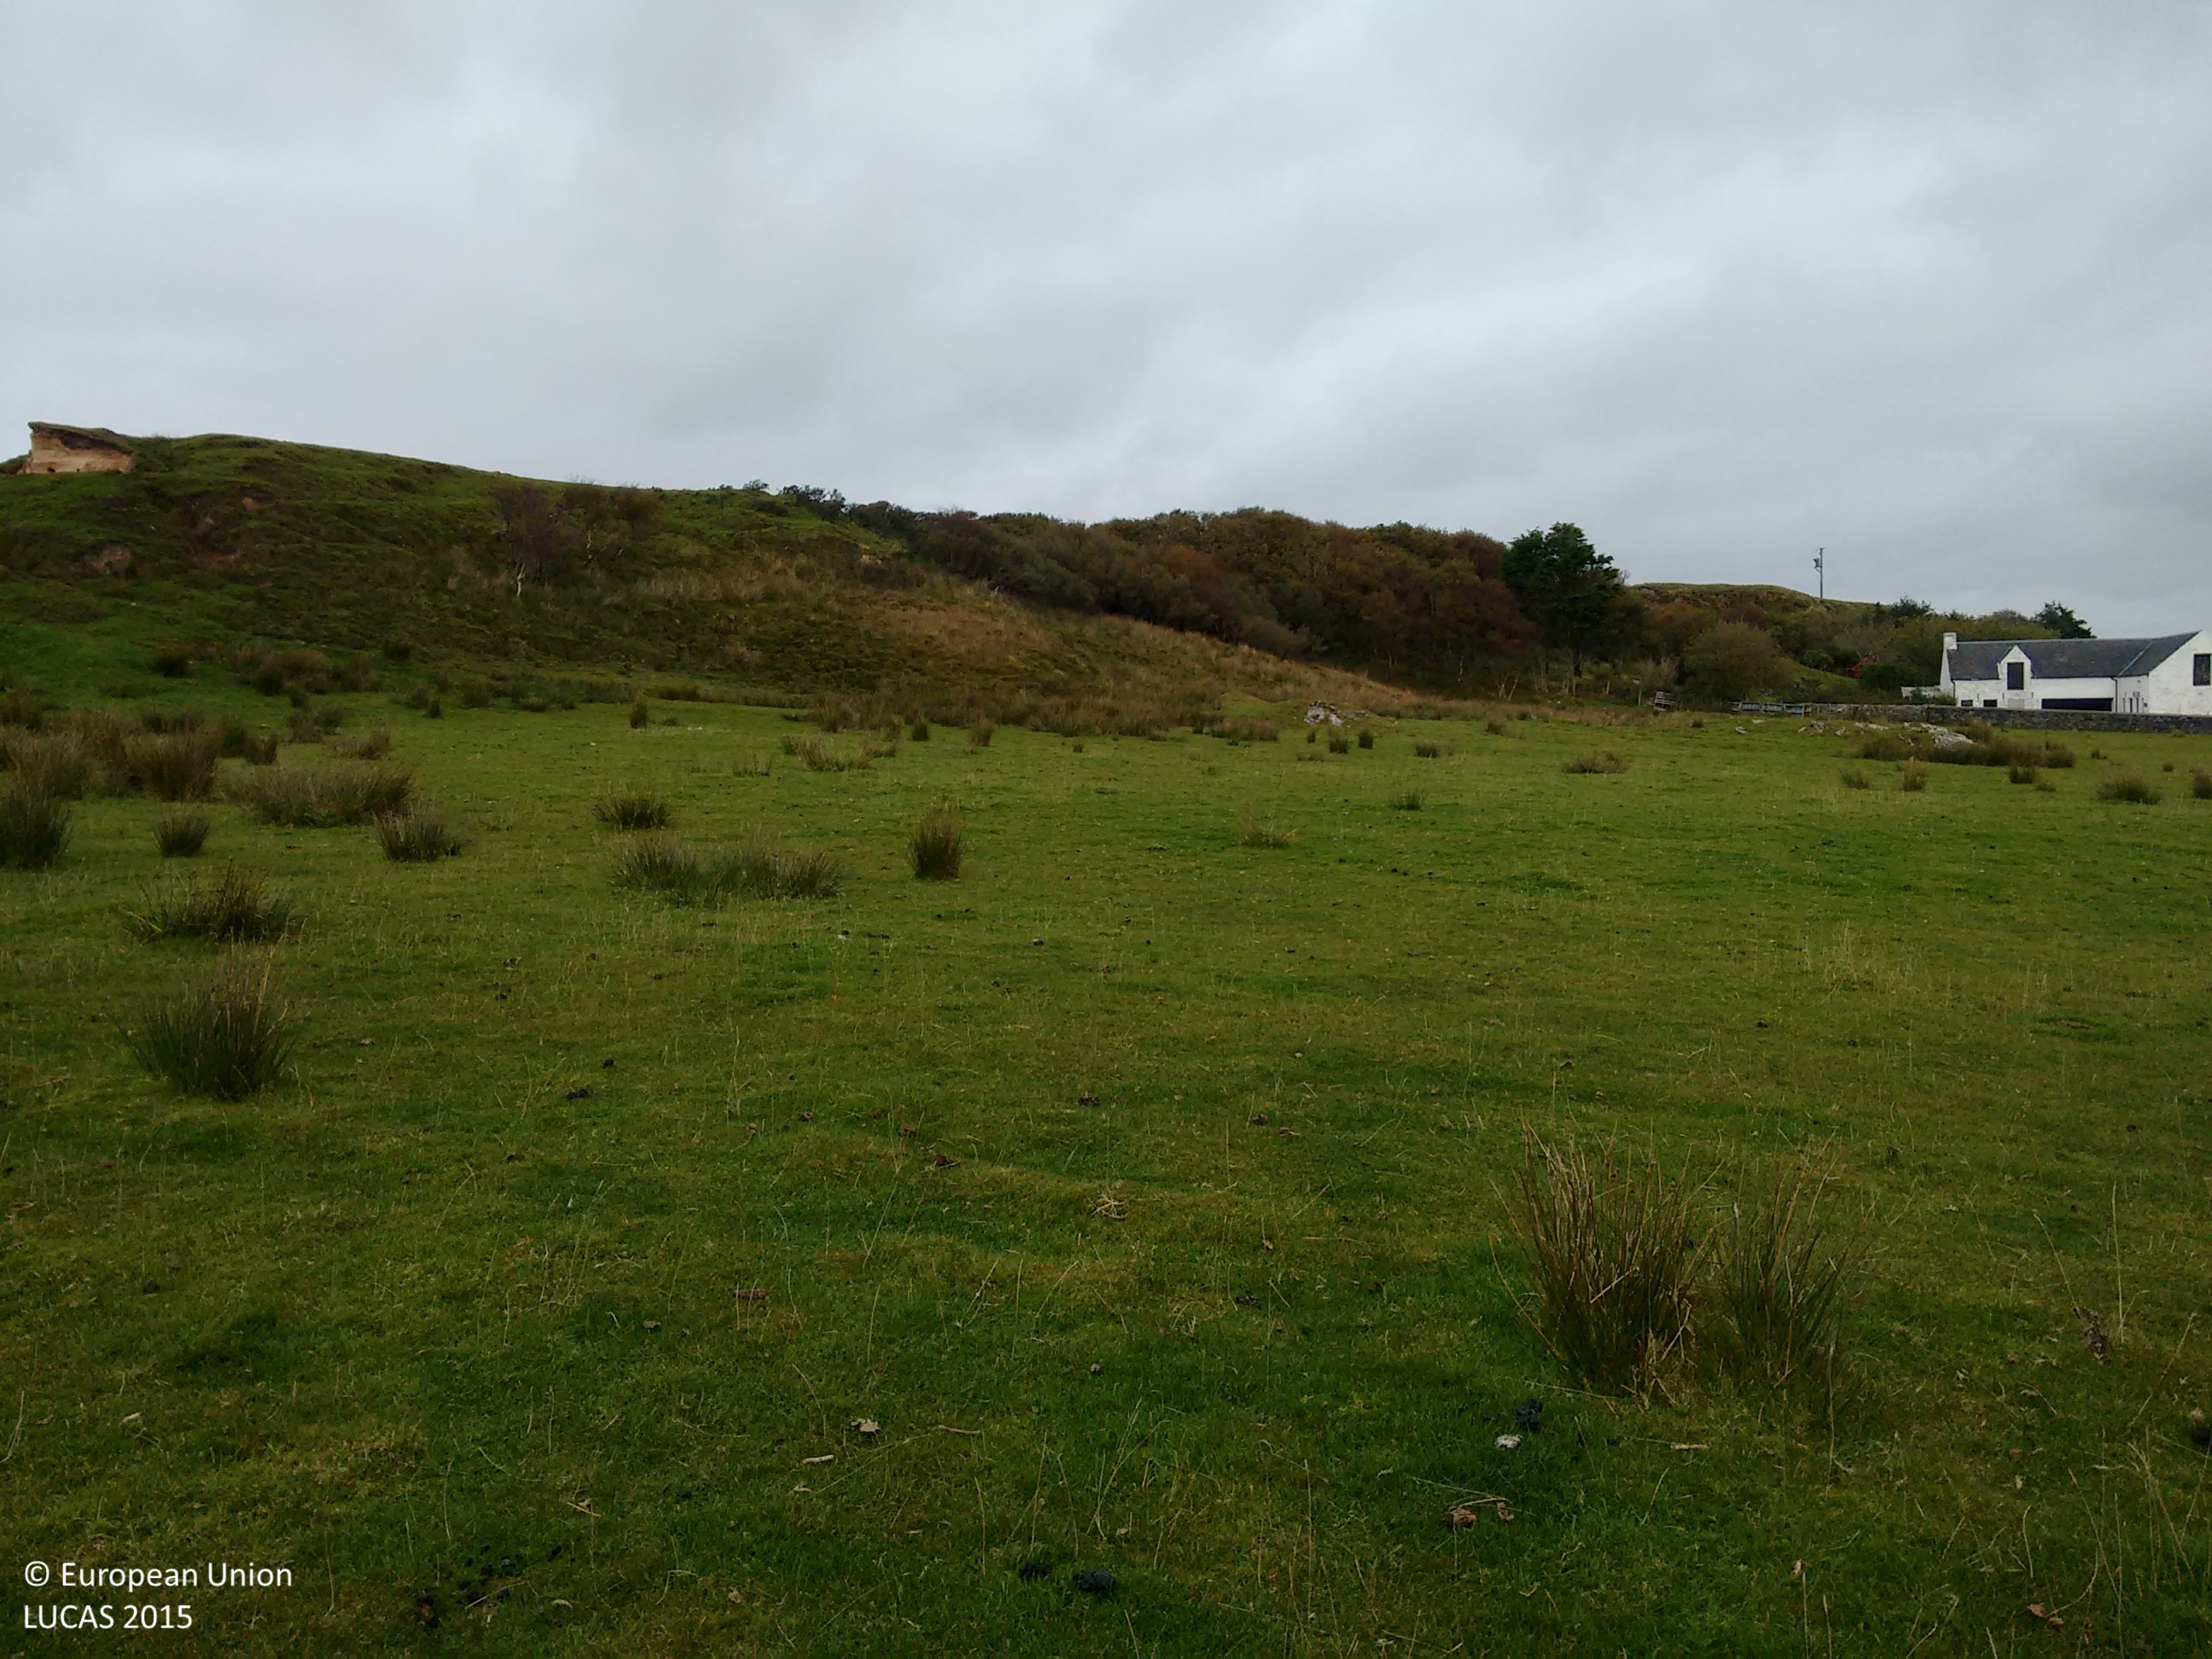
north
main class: Grassland
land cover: Grassland without tree/shrub cover
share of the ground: > 75 %
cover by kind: herbaceous plants 100 %
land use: Agriculture (excluding fallow land and kitchen gardens)
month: October
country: GB
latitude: 55.7709
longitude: -6.3584
